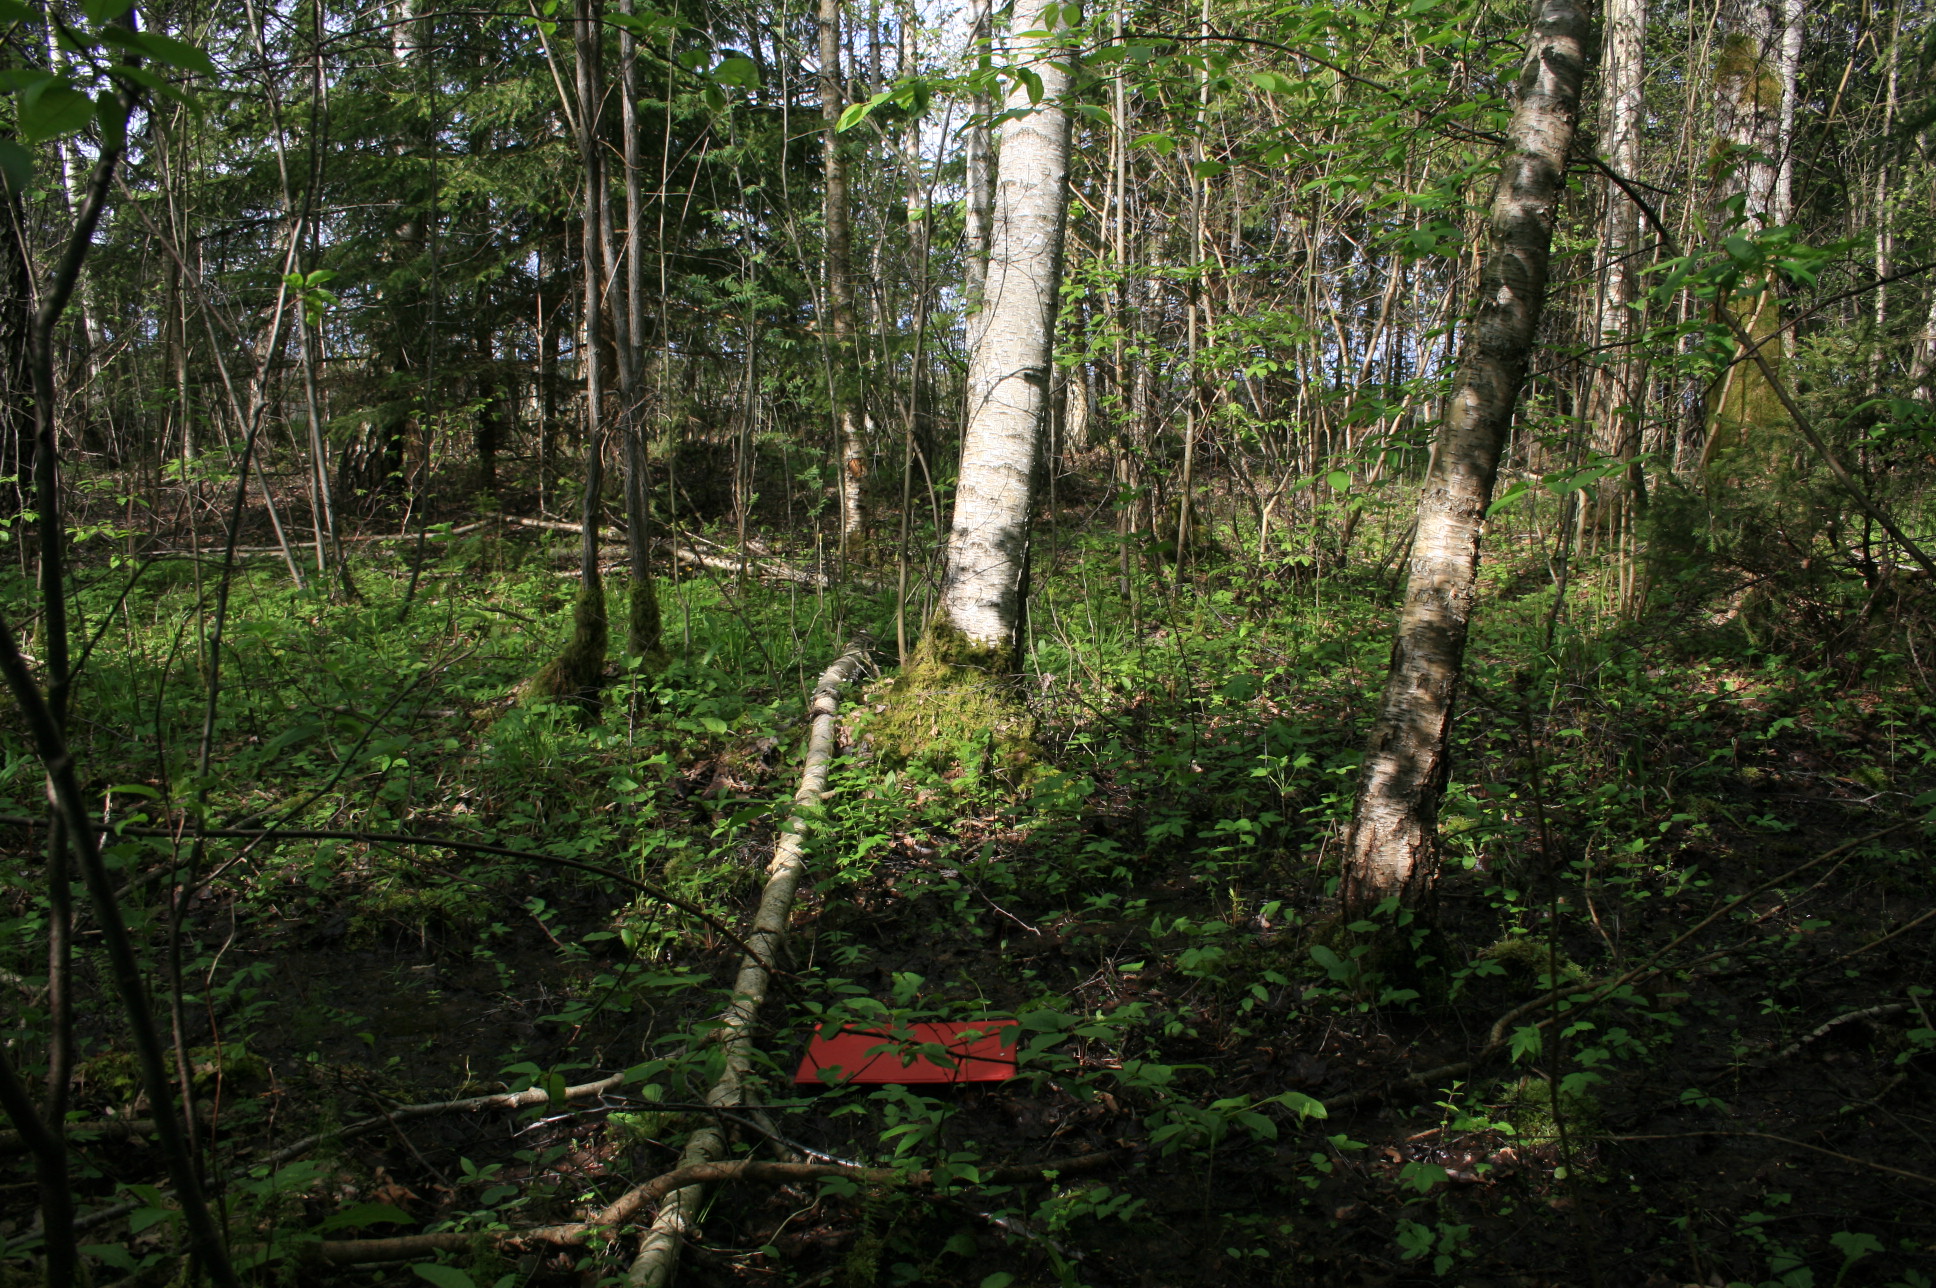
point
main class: Woodland
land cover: Other mixed woodland
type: hemiboreal forest and nemoral coniferous forest and mixed broadleaved-coniferous forest
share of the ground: > 75 %
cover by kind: broadleaved forest trees 60 %, coniferous forest trees 35 %, herbaceous plants 5 %
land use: Forestry
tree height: > 5 m
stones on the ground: < 10 %
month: May
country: LT
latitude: 56.2250
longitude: 21.3801
